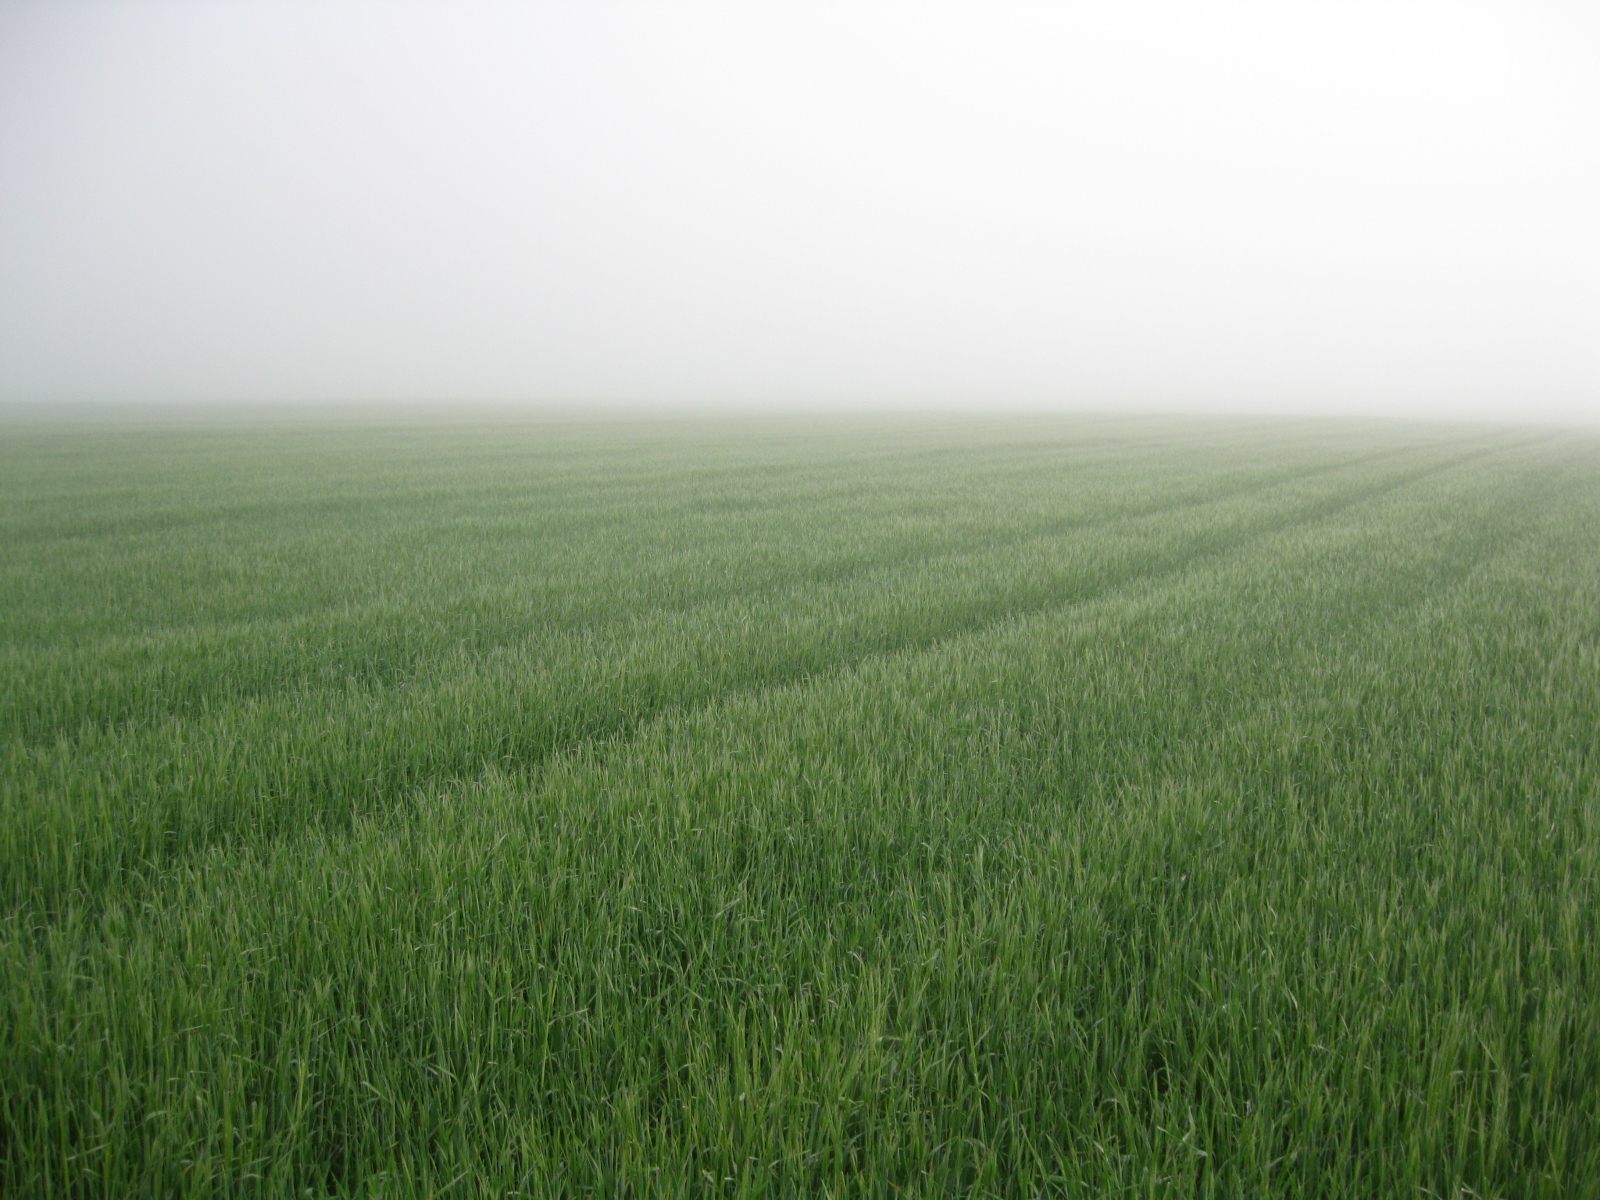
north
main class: Cropland
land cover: Barley
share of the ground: > 75 %
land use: Agriculture (excluding fallow land and kitchen gardens)
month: June
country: LT
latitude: 55.4740
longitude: 23.9628
